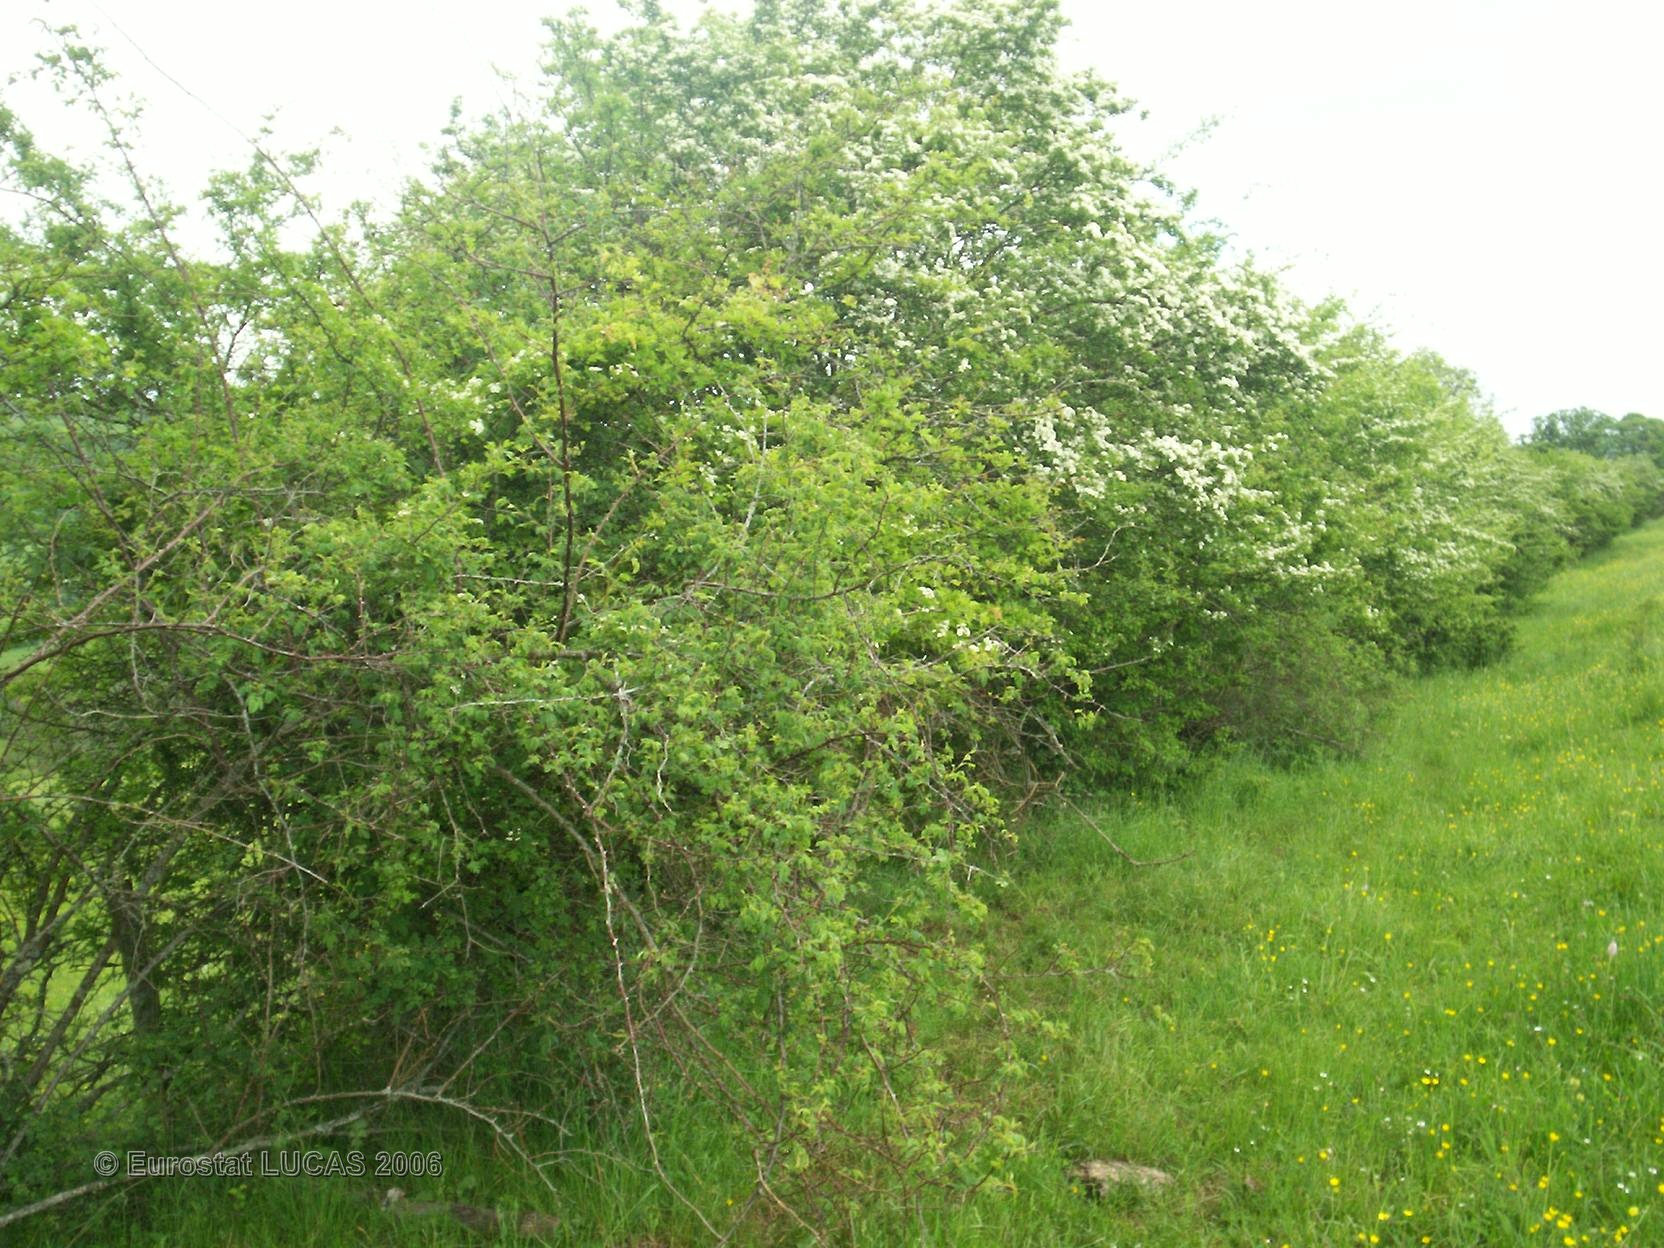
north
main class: Grassland
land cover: Grassland without tree/shrub cover
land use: Agriculture (excluding fallow land and kitchen gardens)
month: May
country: FR
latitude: 47.1741
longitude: 4.6565
